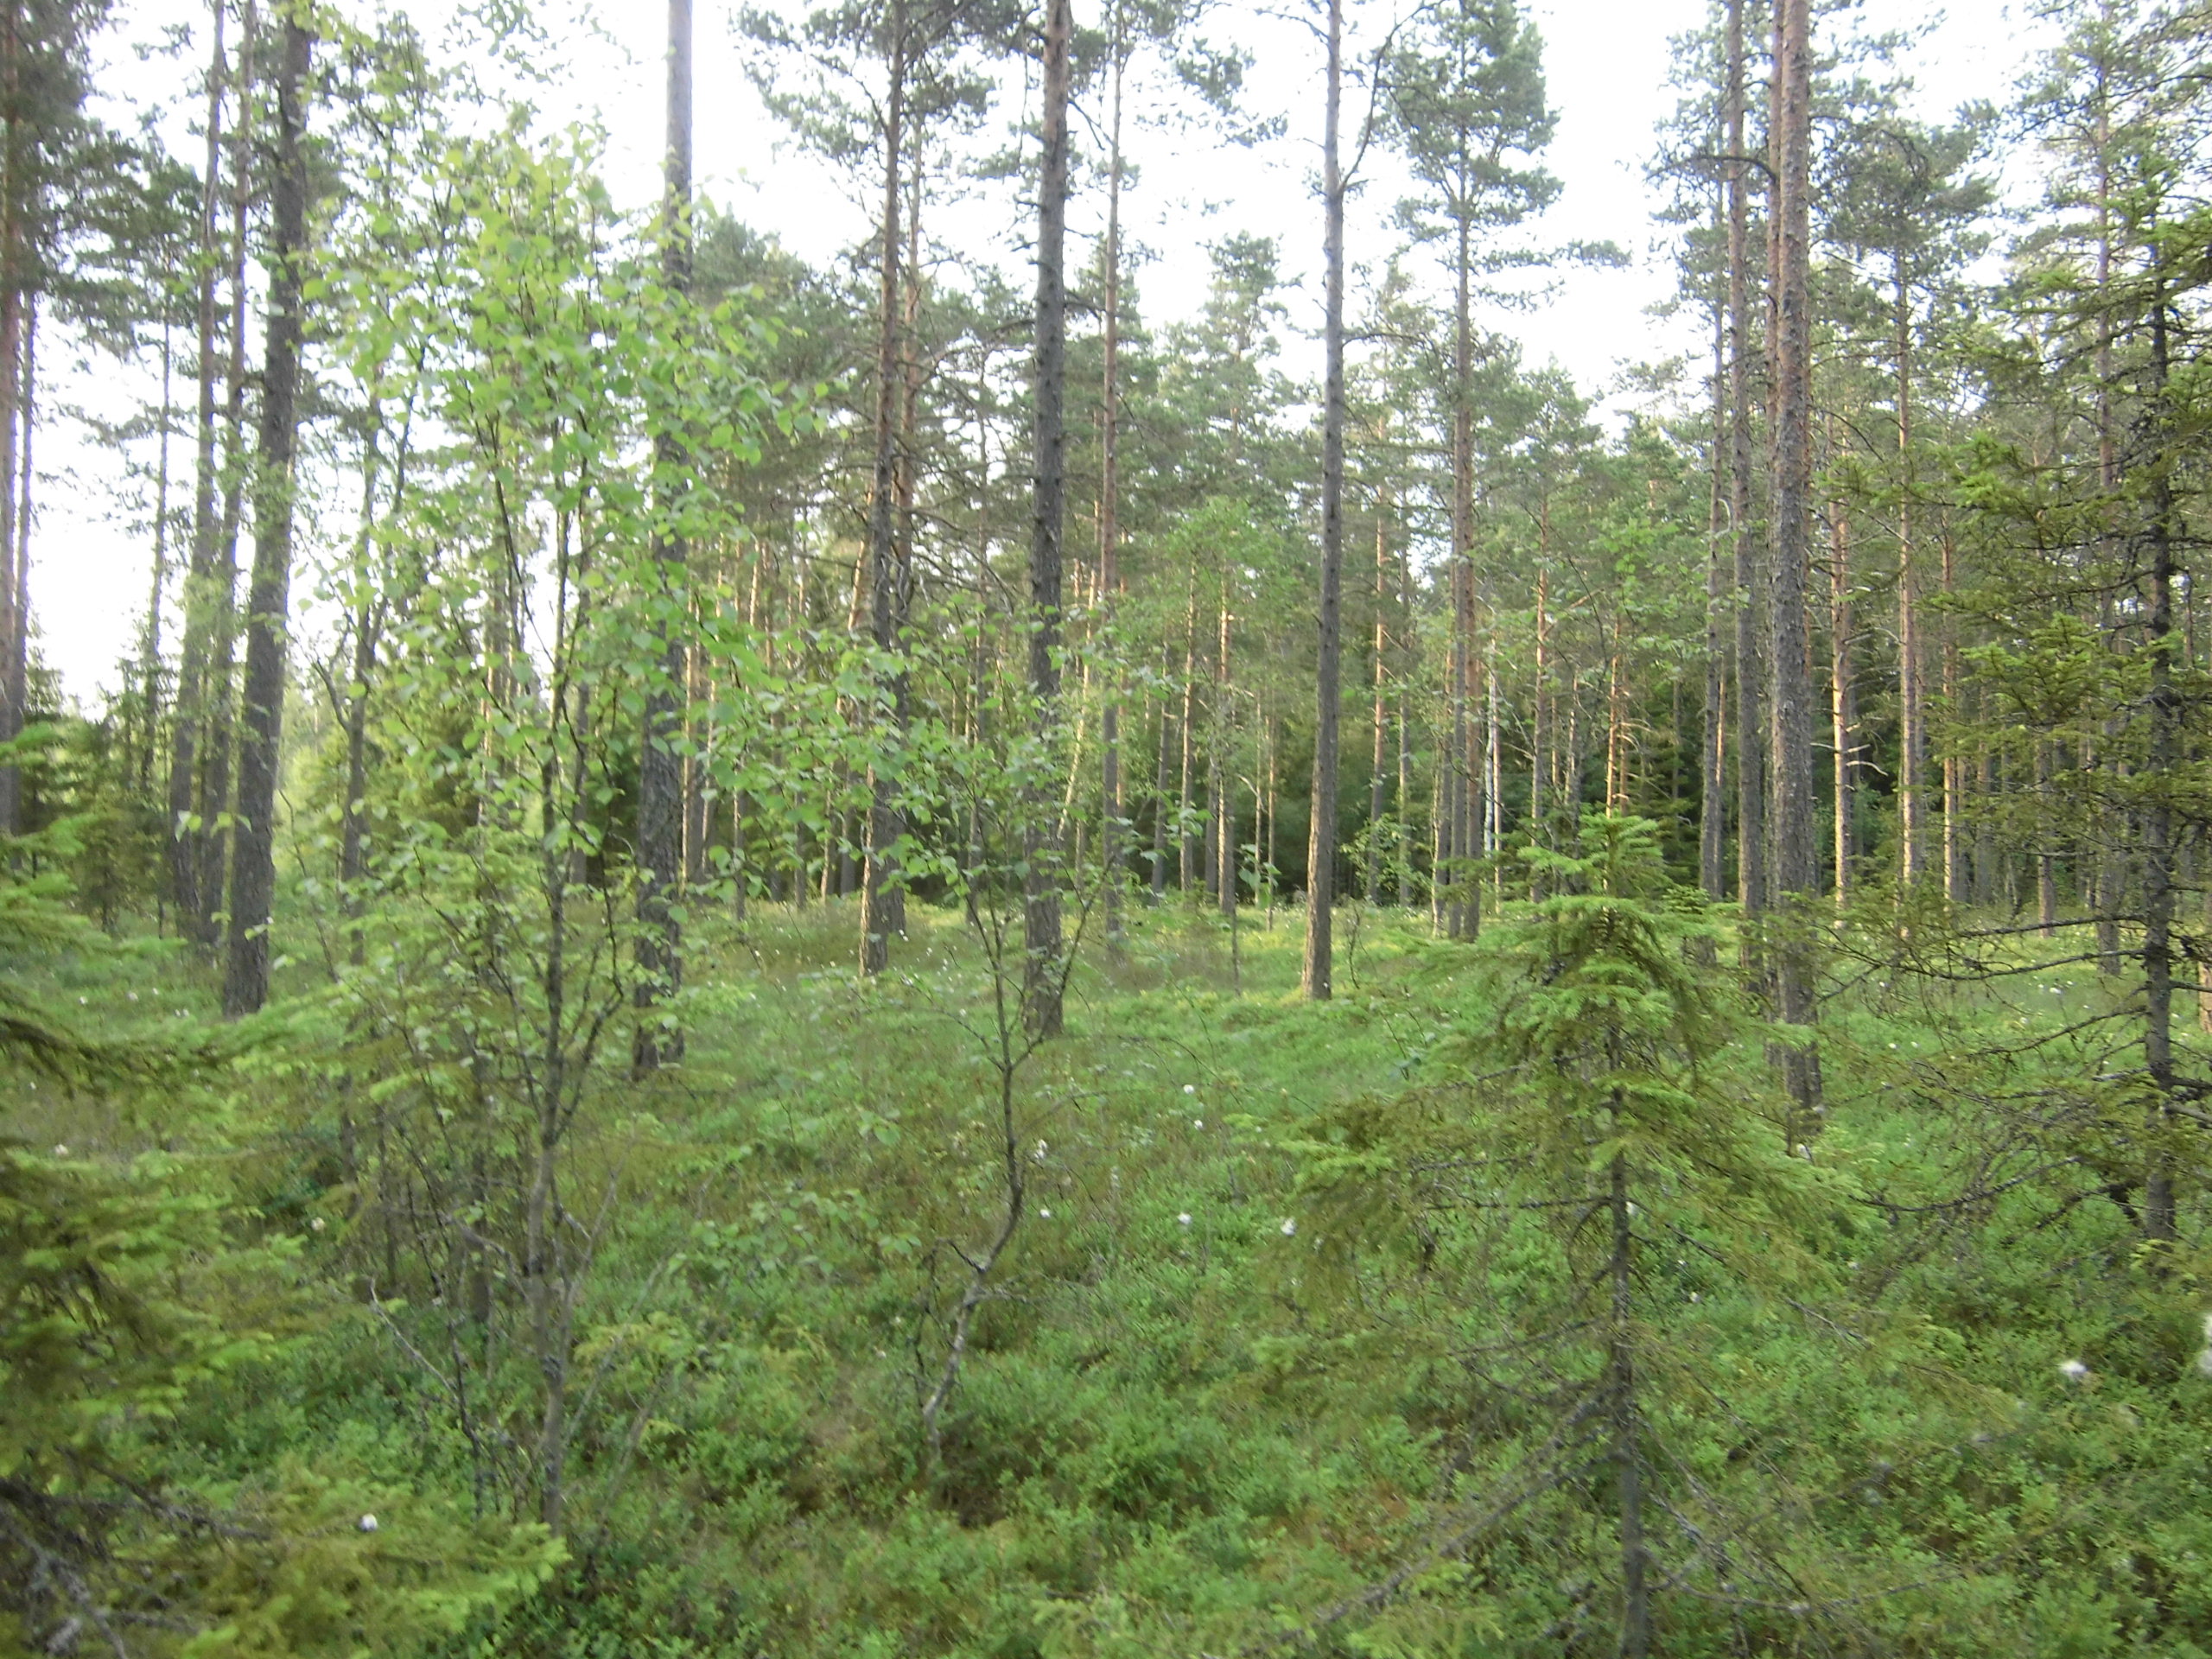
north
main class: Woodland
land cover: Pine dominated coniferous woodland
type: boreal forest
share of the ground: 50 - 75 %
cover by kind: coniferous forest trees 50 %, shrubs 30 %, lichens and mosses 10 %, broadleaved forest trees 5 %, herbaceous plants 5 %
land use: Forestry
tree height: > 5 m
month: July
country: SE
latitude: 57.3052
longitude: 14.7934
